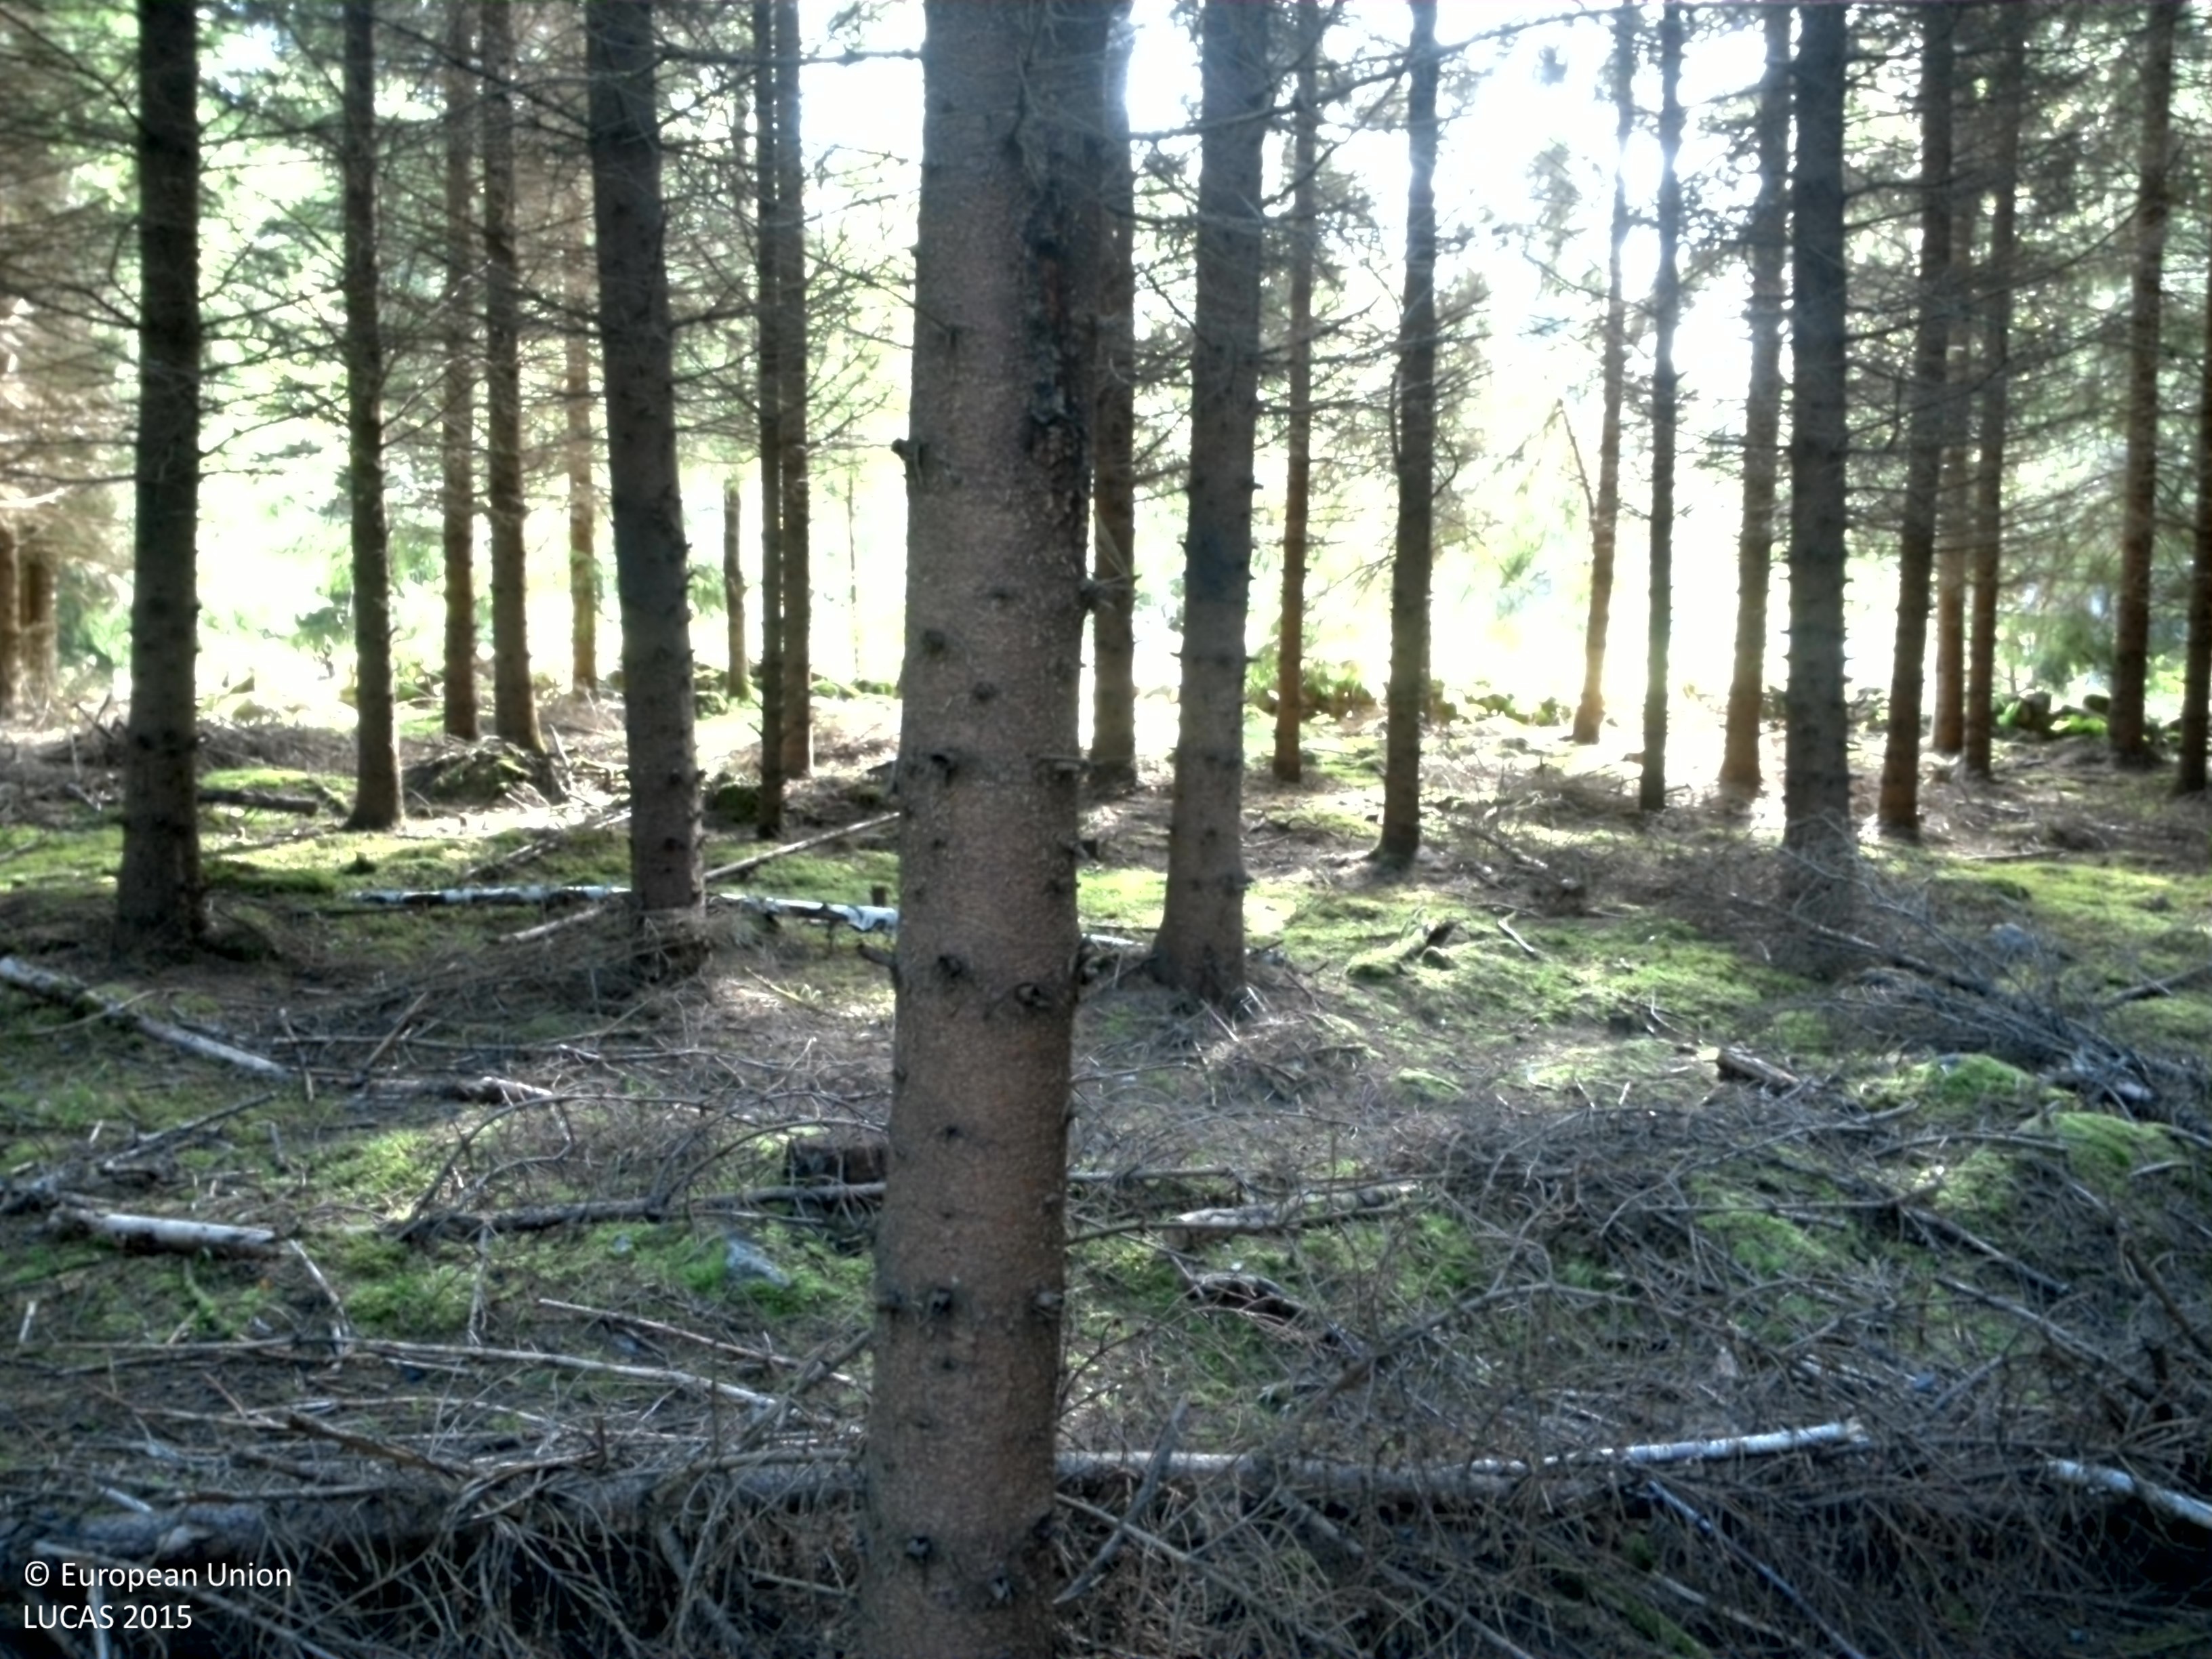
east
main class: Woodland
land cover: Spruce dominated coniferous woodland
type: boreal forest
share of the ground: > 75 %
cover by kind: coniferous forest trees 90 %, lichens and mosses 5 %, unconsolidated bare surface 5 %
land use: Forestry
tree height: > 5 m
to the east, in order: Spruce dominated coniferous woodland; Dry stone walls; Broadleaved woodland; Spruce dominated coniferous woodland; Ditches and canals; Paved roads, cycling and walking lanes; Grass margins; Ditches and canals; Fences; Temporary grasslands; Electric lines; Temporary grasslands; Fences; Dry stone walls; Broadleaved woodland; Tracks; Broadleaved woodland; Spruce dominated coniferous woodland; Dry stone walls; Spruce dominated coniferous woodland; Spruce dominated mixed woodland
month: August
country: SE
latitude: 58.1779
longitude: 13.3443
